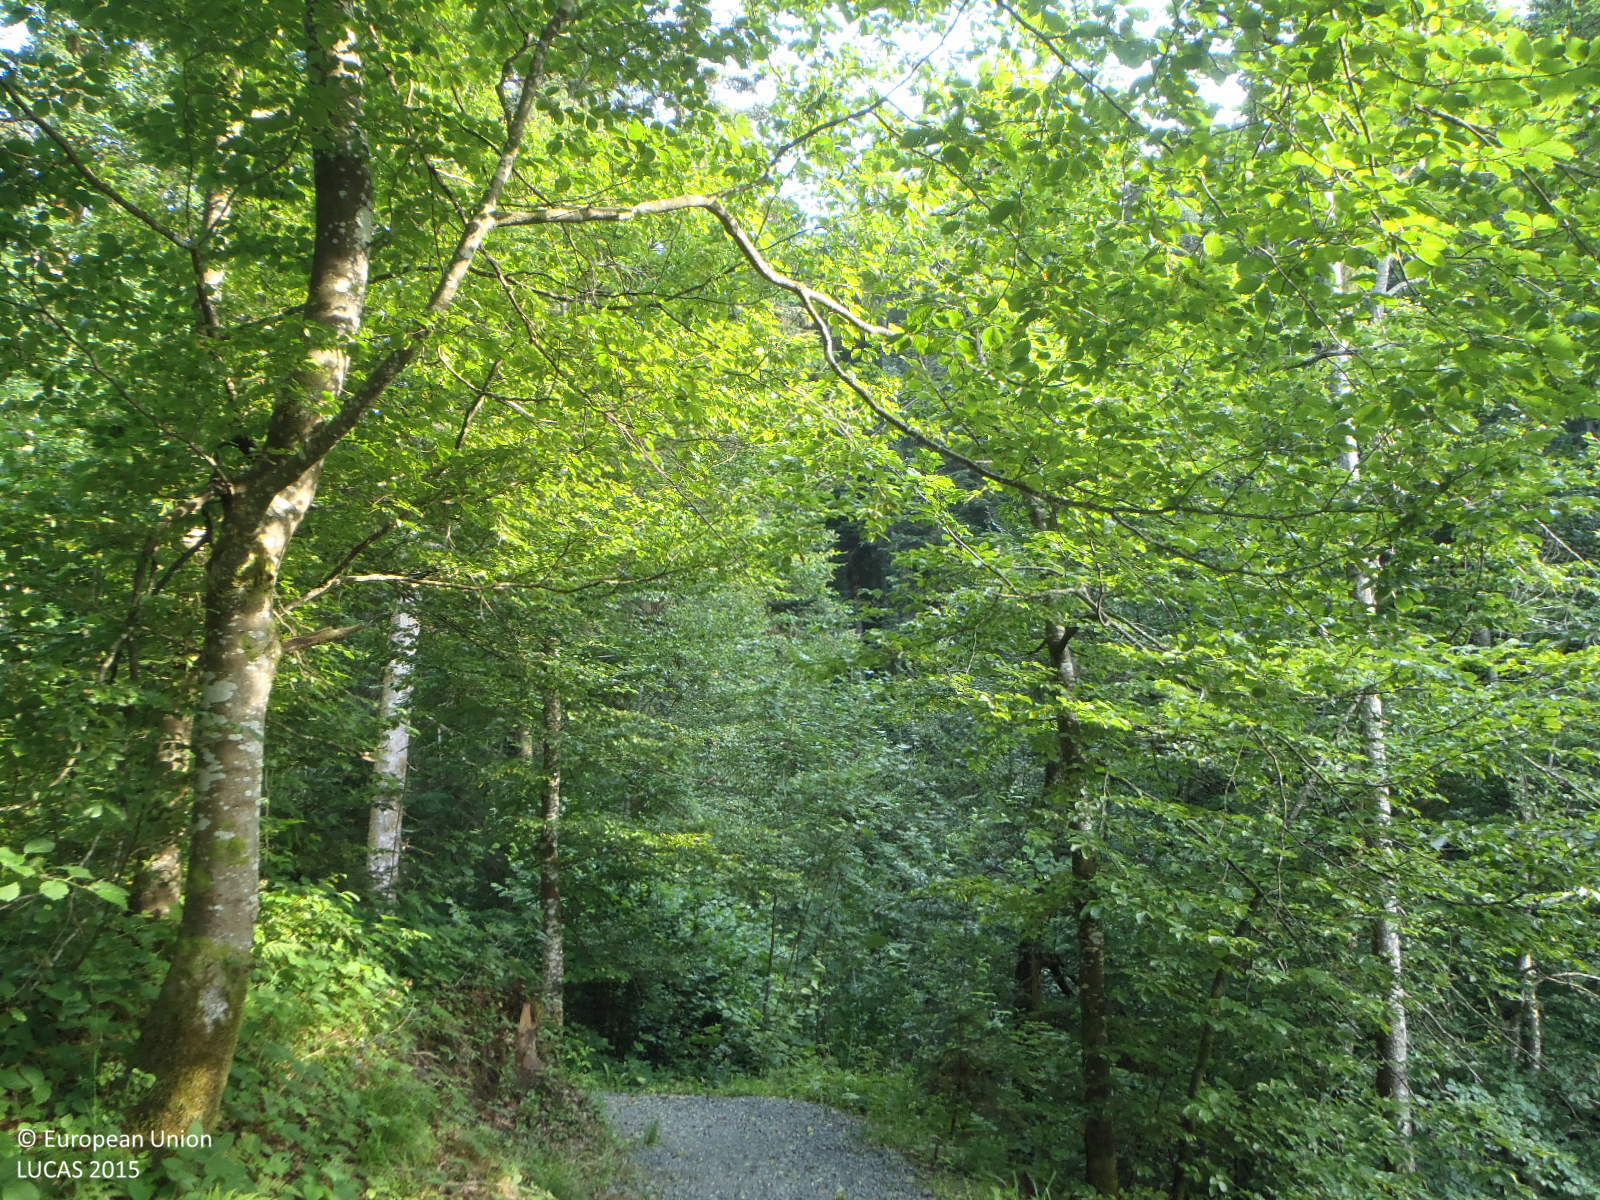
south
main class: Woodland
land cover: Other mixed woodland
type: alpine coniferous forest
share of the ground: > 75 %
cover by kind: coniferous forest trees 35 %, broadleaved forest trees 30 %, shrubs 20 %, herbaceous plants 15 %
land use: Forestry
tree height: > 5 m
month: July
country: AT
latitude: 47.5126
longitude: 12.4283
